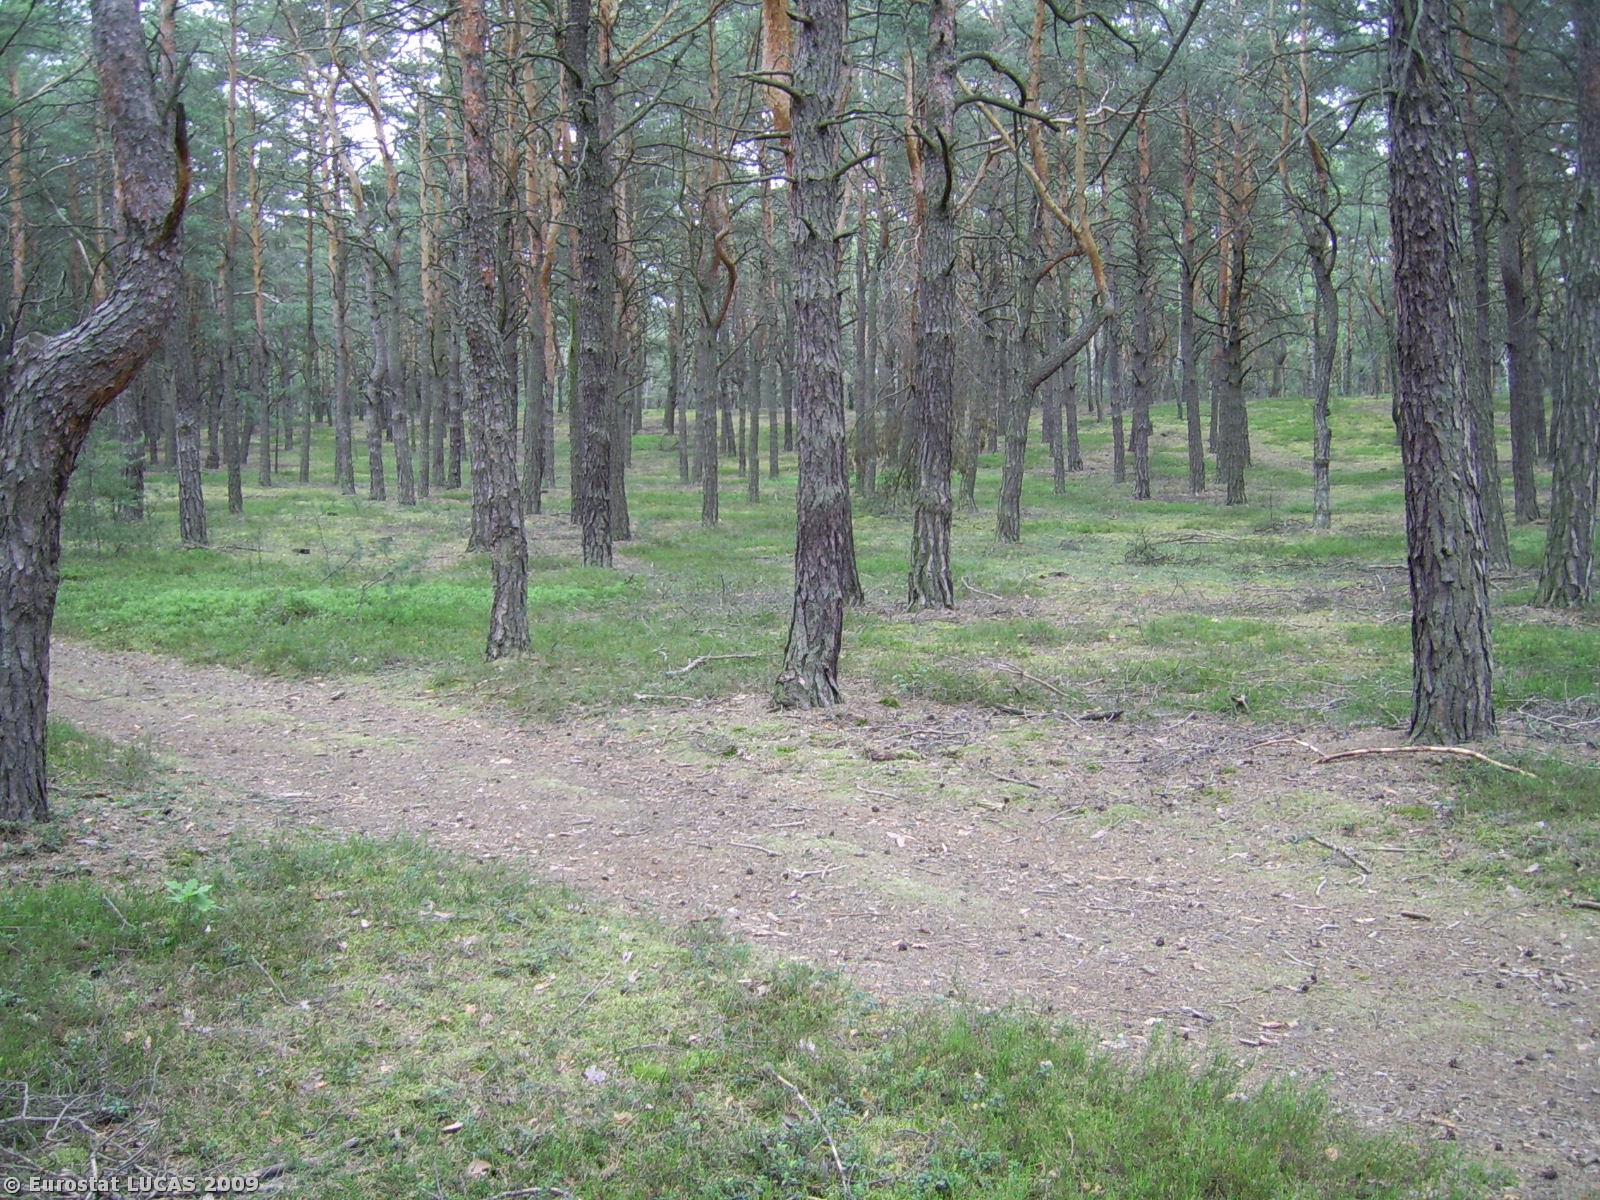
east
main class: Woodland
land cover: Coniferous woodland
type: hemiboreal forest and nemoral coniferous forest and mixed broadleaved-coniferous forest
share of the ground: 50 - 75 %
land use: Forestry
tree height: > 5 m
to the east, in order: Coniferous woodland; Tracks; Coniferous woodland
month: June
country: PL
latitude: 52.0493
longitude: 17.7865
